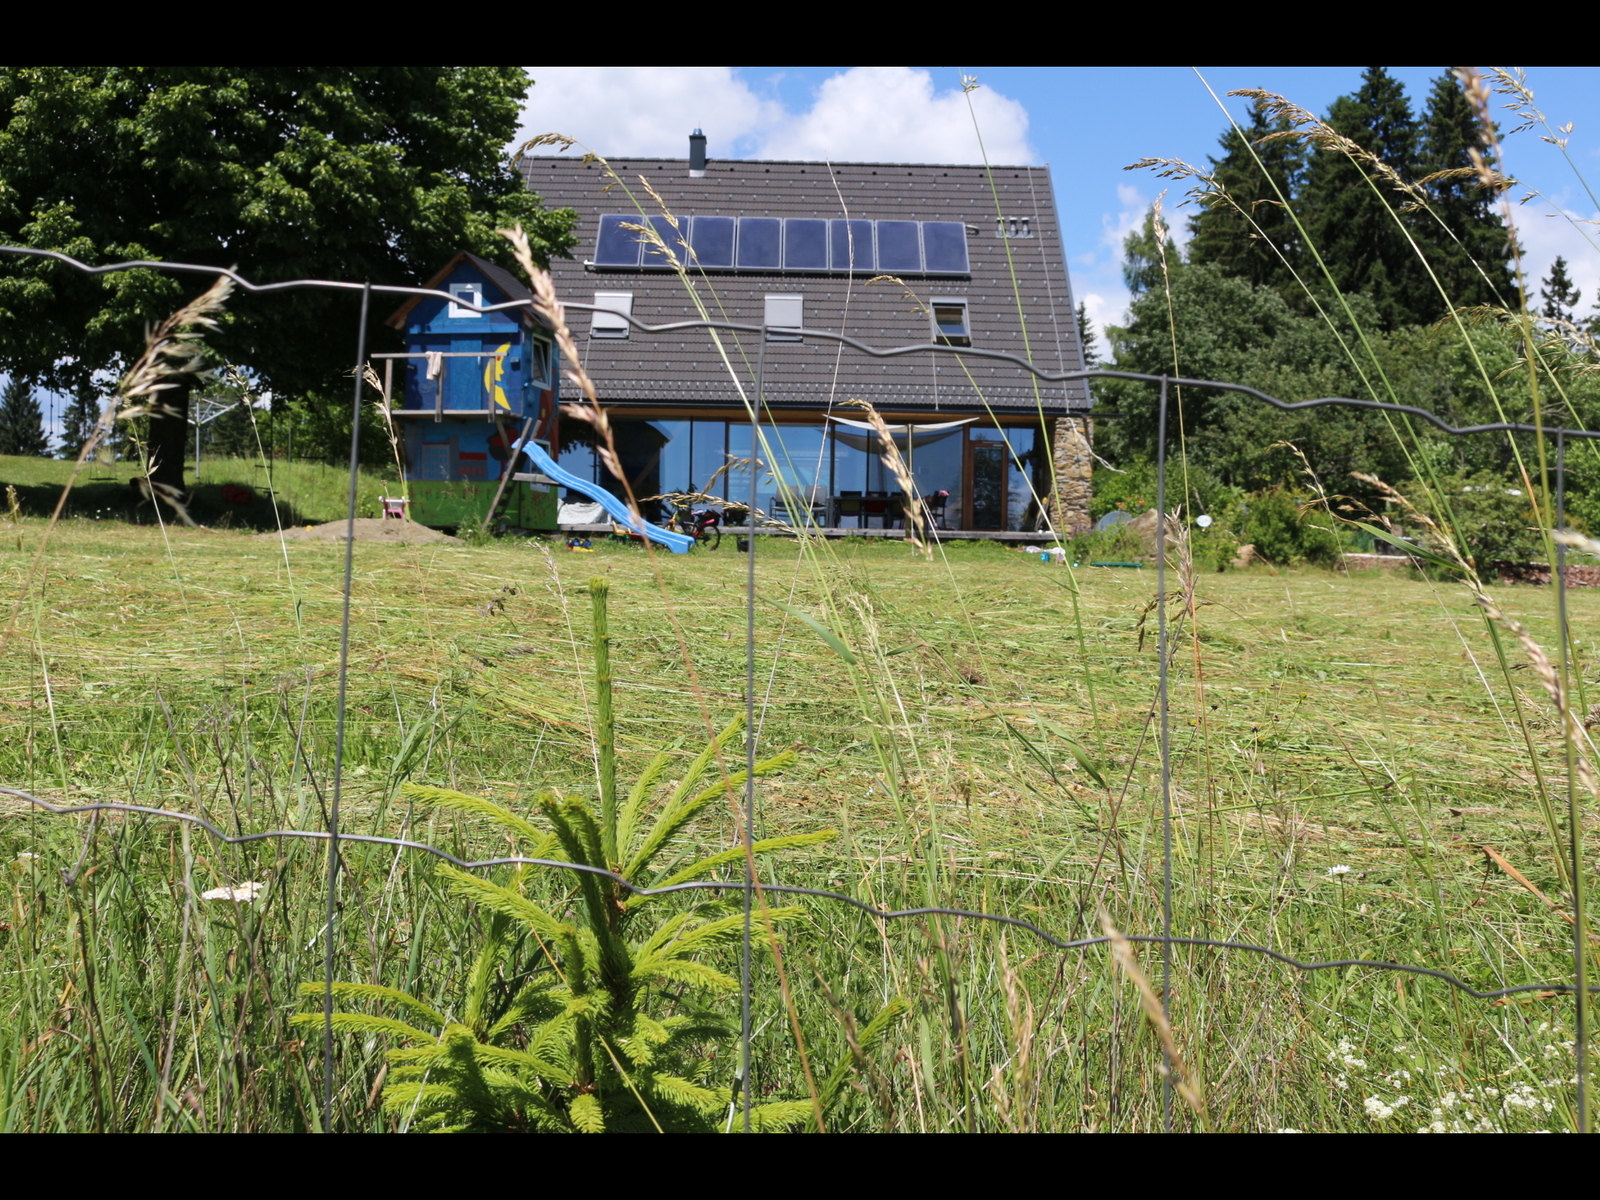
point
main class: Grassland
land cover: Grassland without tree/shrub cover
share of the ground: > 75 %
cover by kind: herbaceous plants 100 %
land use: Agriculture (excluding fallow land and kitchen gardens)
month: June
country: AT
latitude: 46.8763
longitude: 14.3410
